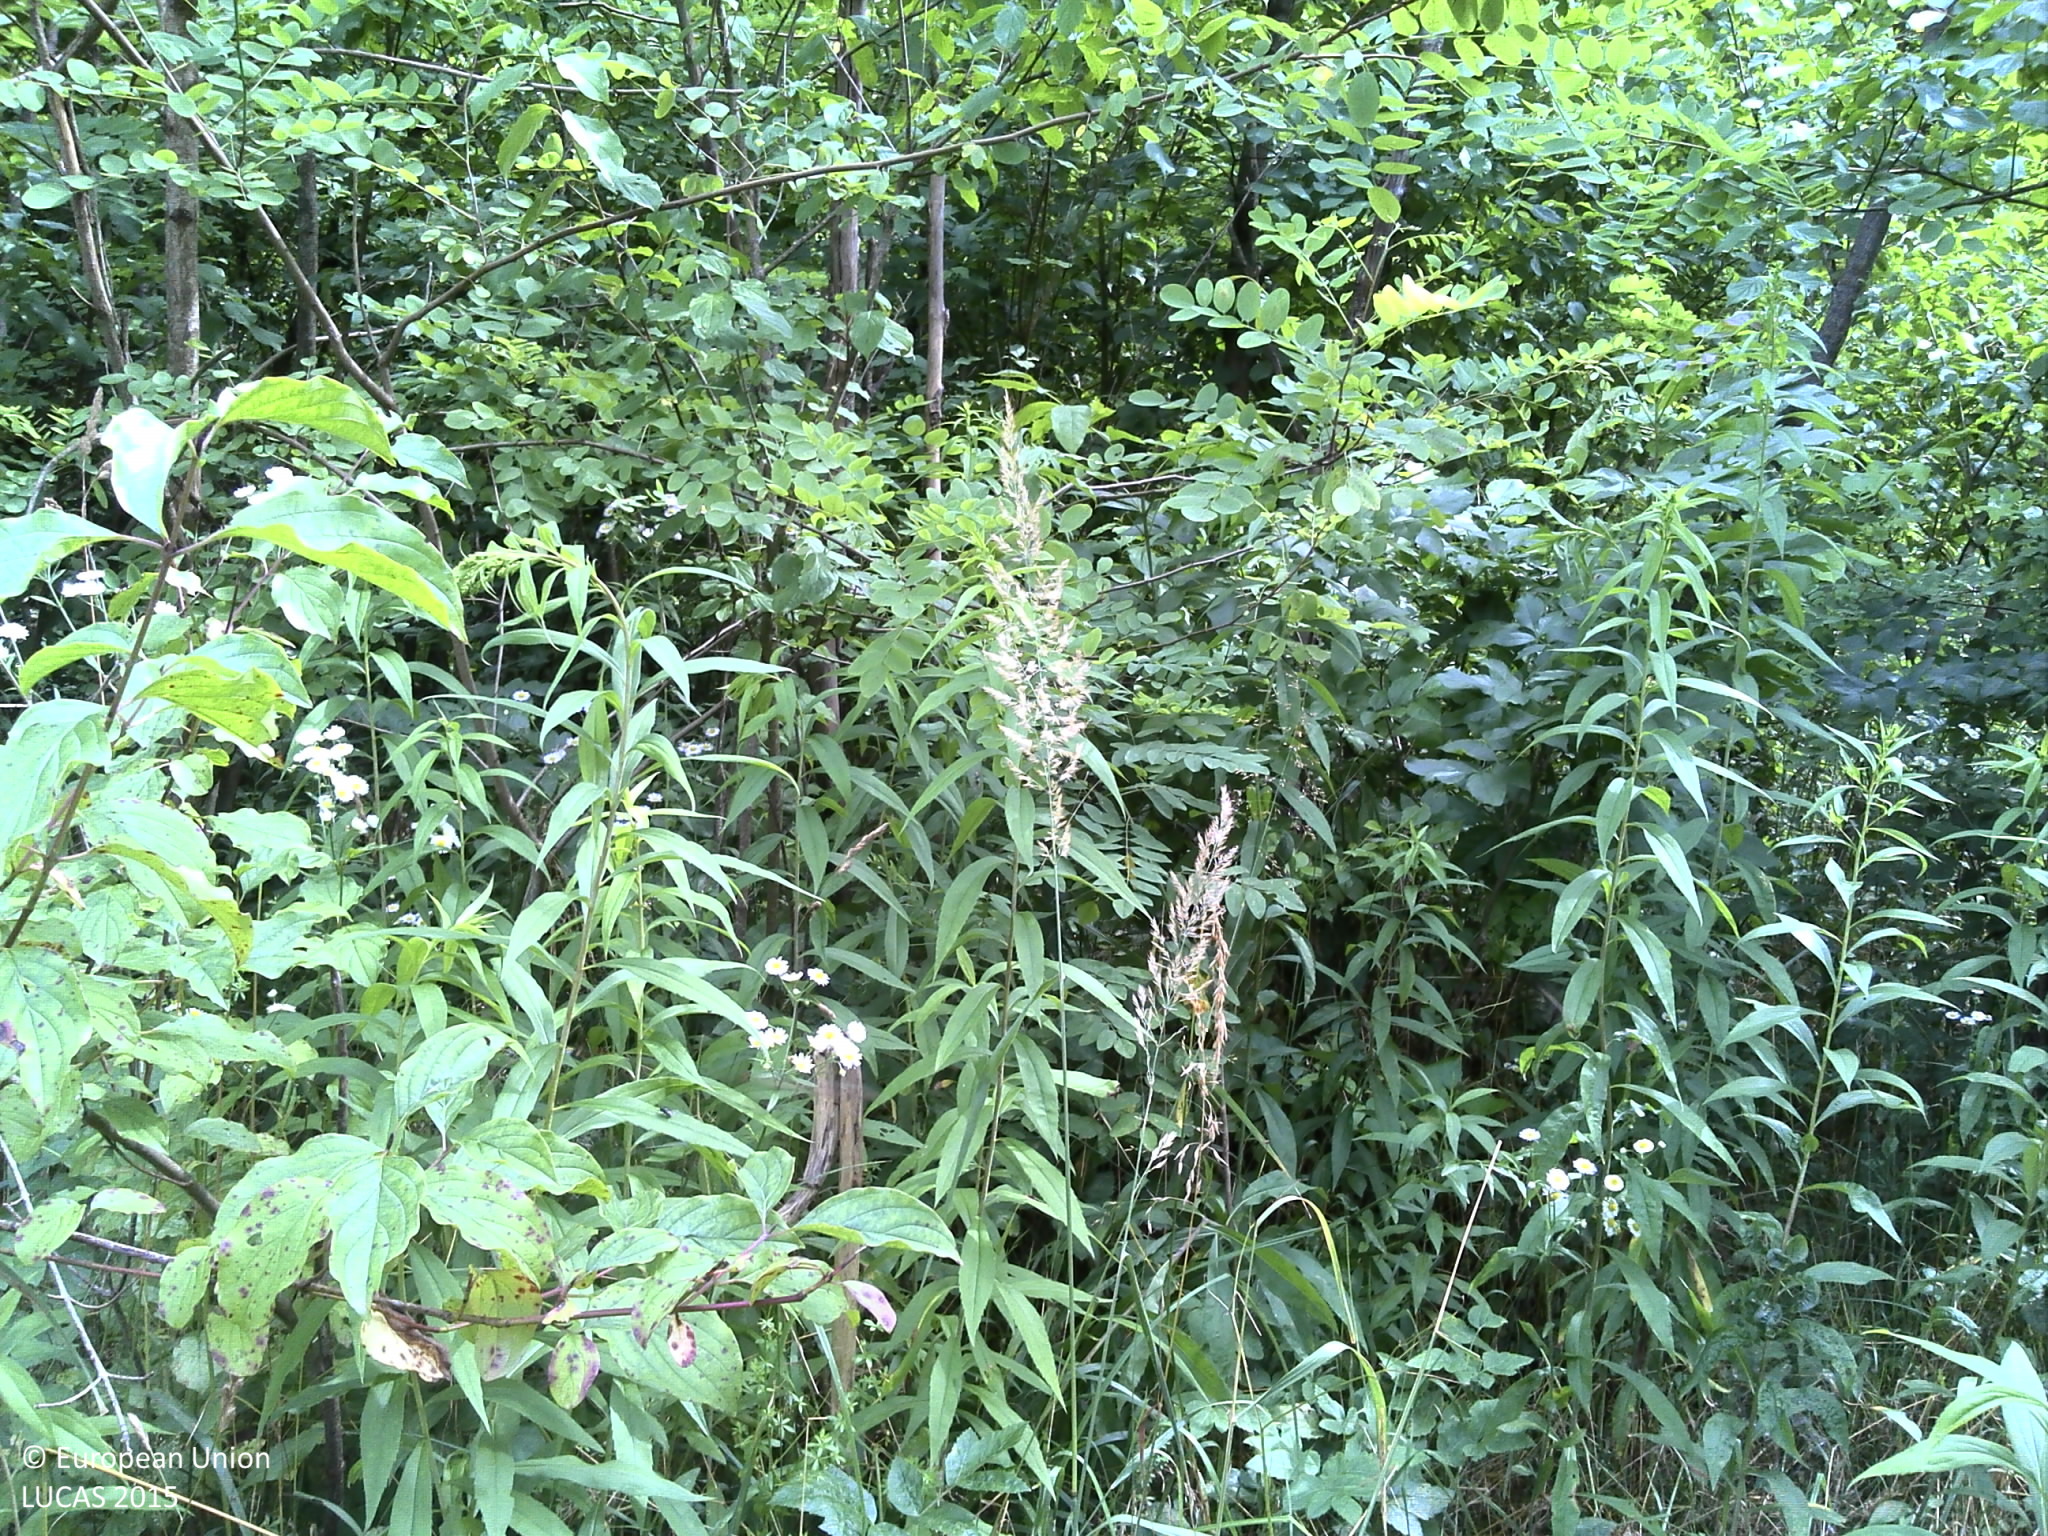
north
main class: Shrubland
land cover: Shrubland with sparse tree cover
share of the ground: > 75 %
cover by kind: shrubs 95 %, broadleaved forest trees 5 %
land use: Forestry
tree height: > 5 m
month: June
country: HR
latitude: 45.9557
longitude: 17.3179
